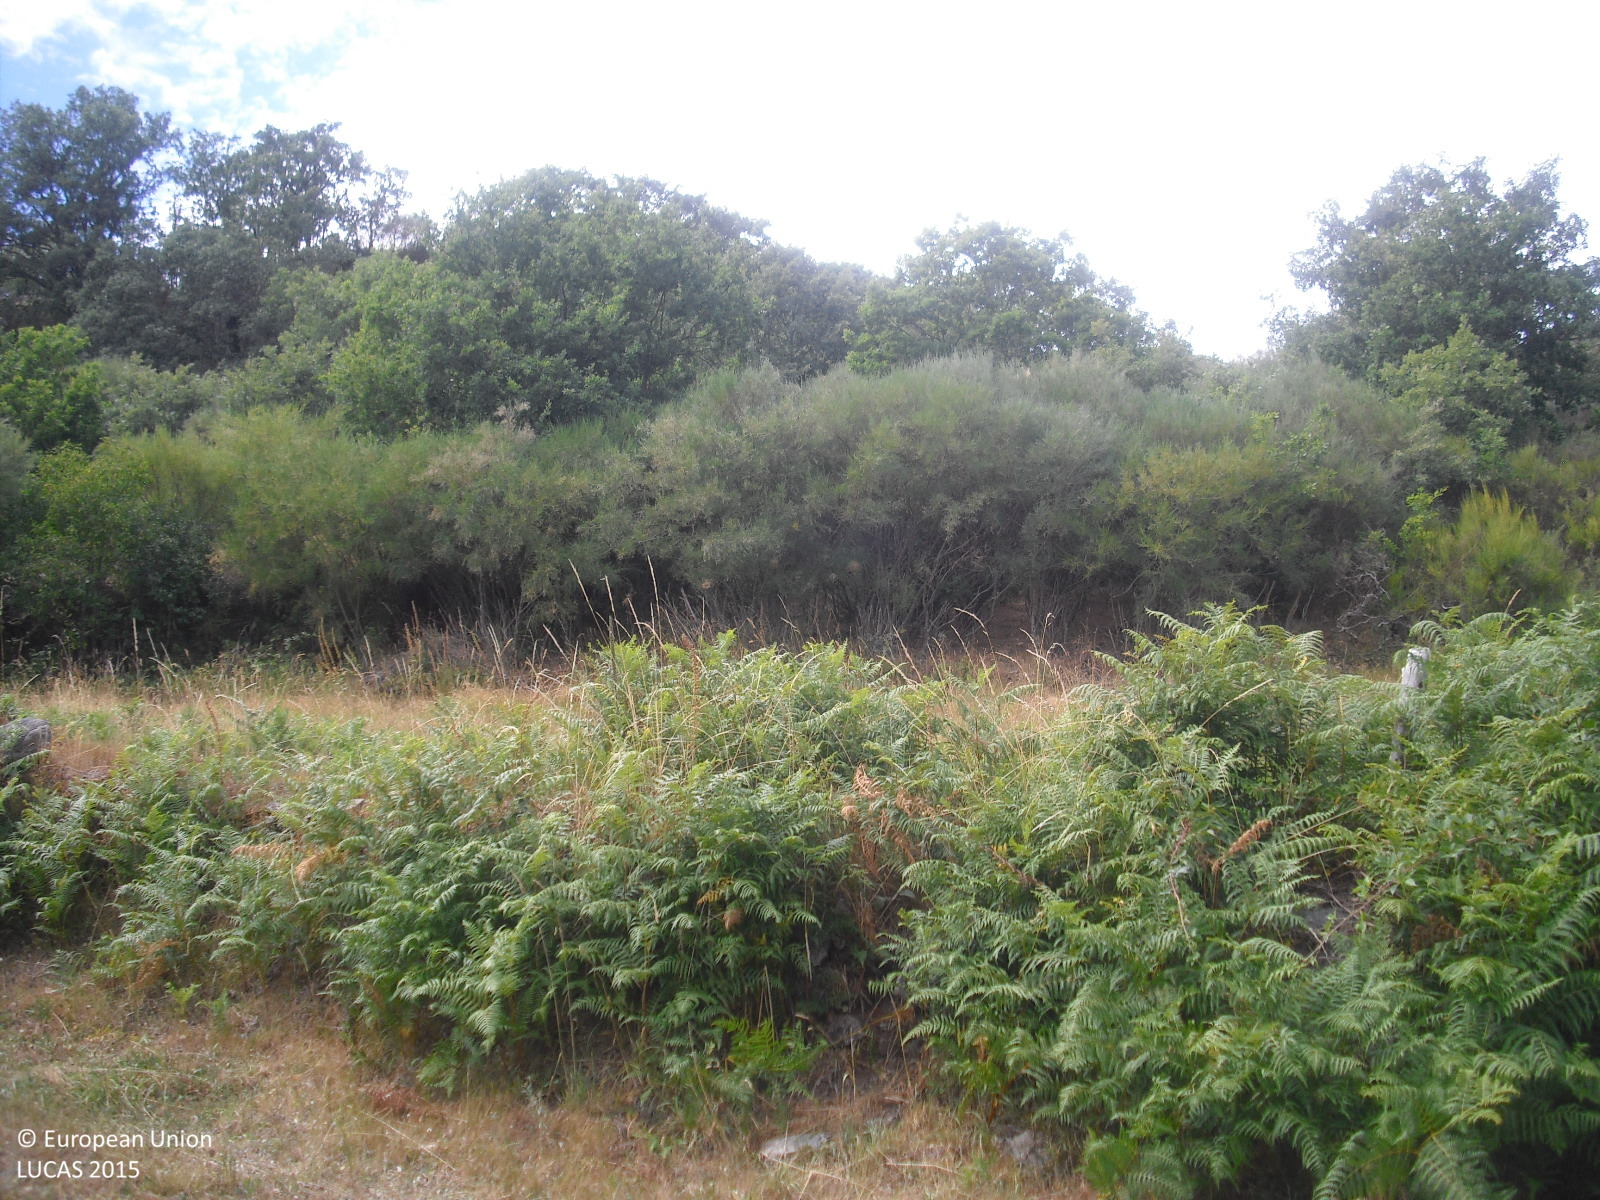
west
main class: Grassland
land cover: Grassland without tree/shrub cover
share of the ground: > 75 %
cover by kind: herbaceous plants 100 %
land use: Agriculture (excluding fallow land and kitchen gardens)
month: July
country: ES
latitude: 42.2301
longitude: -7.3519
